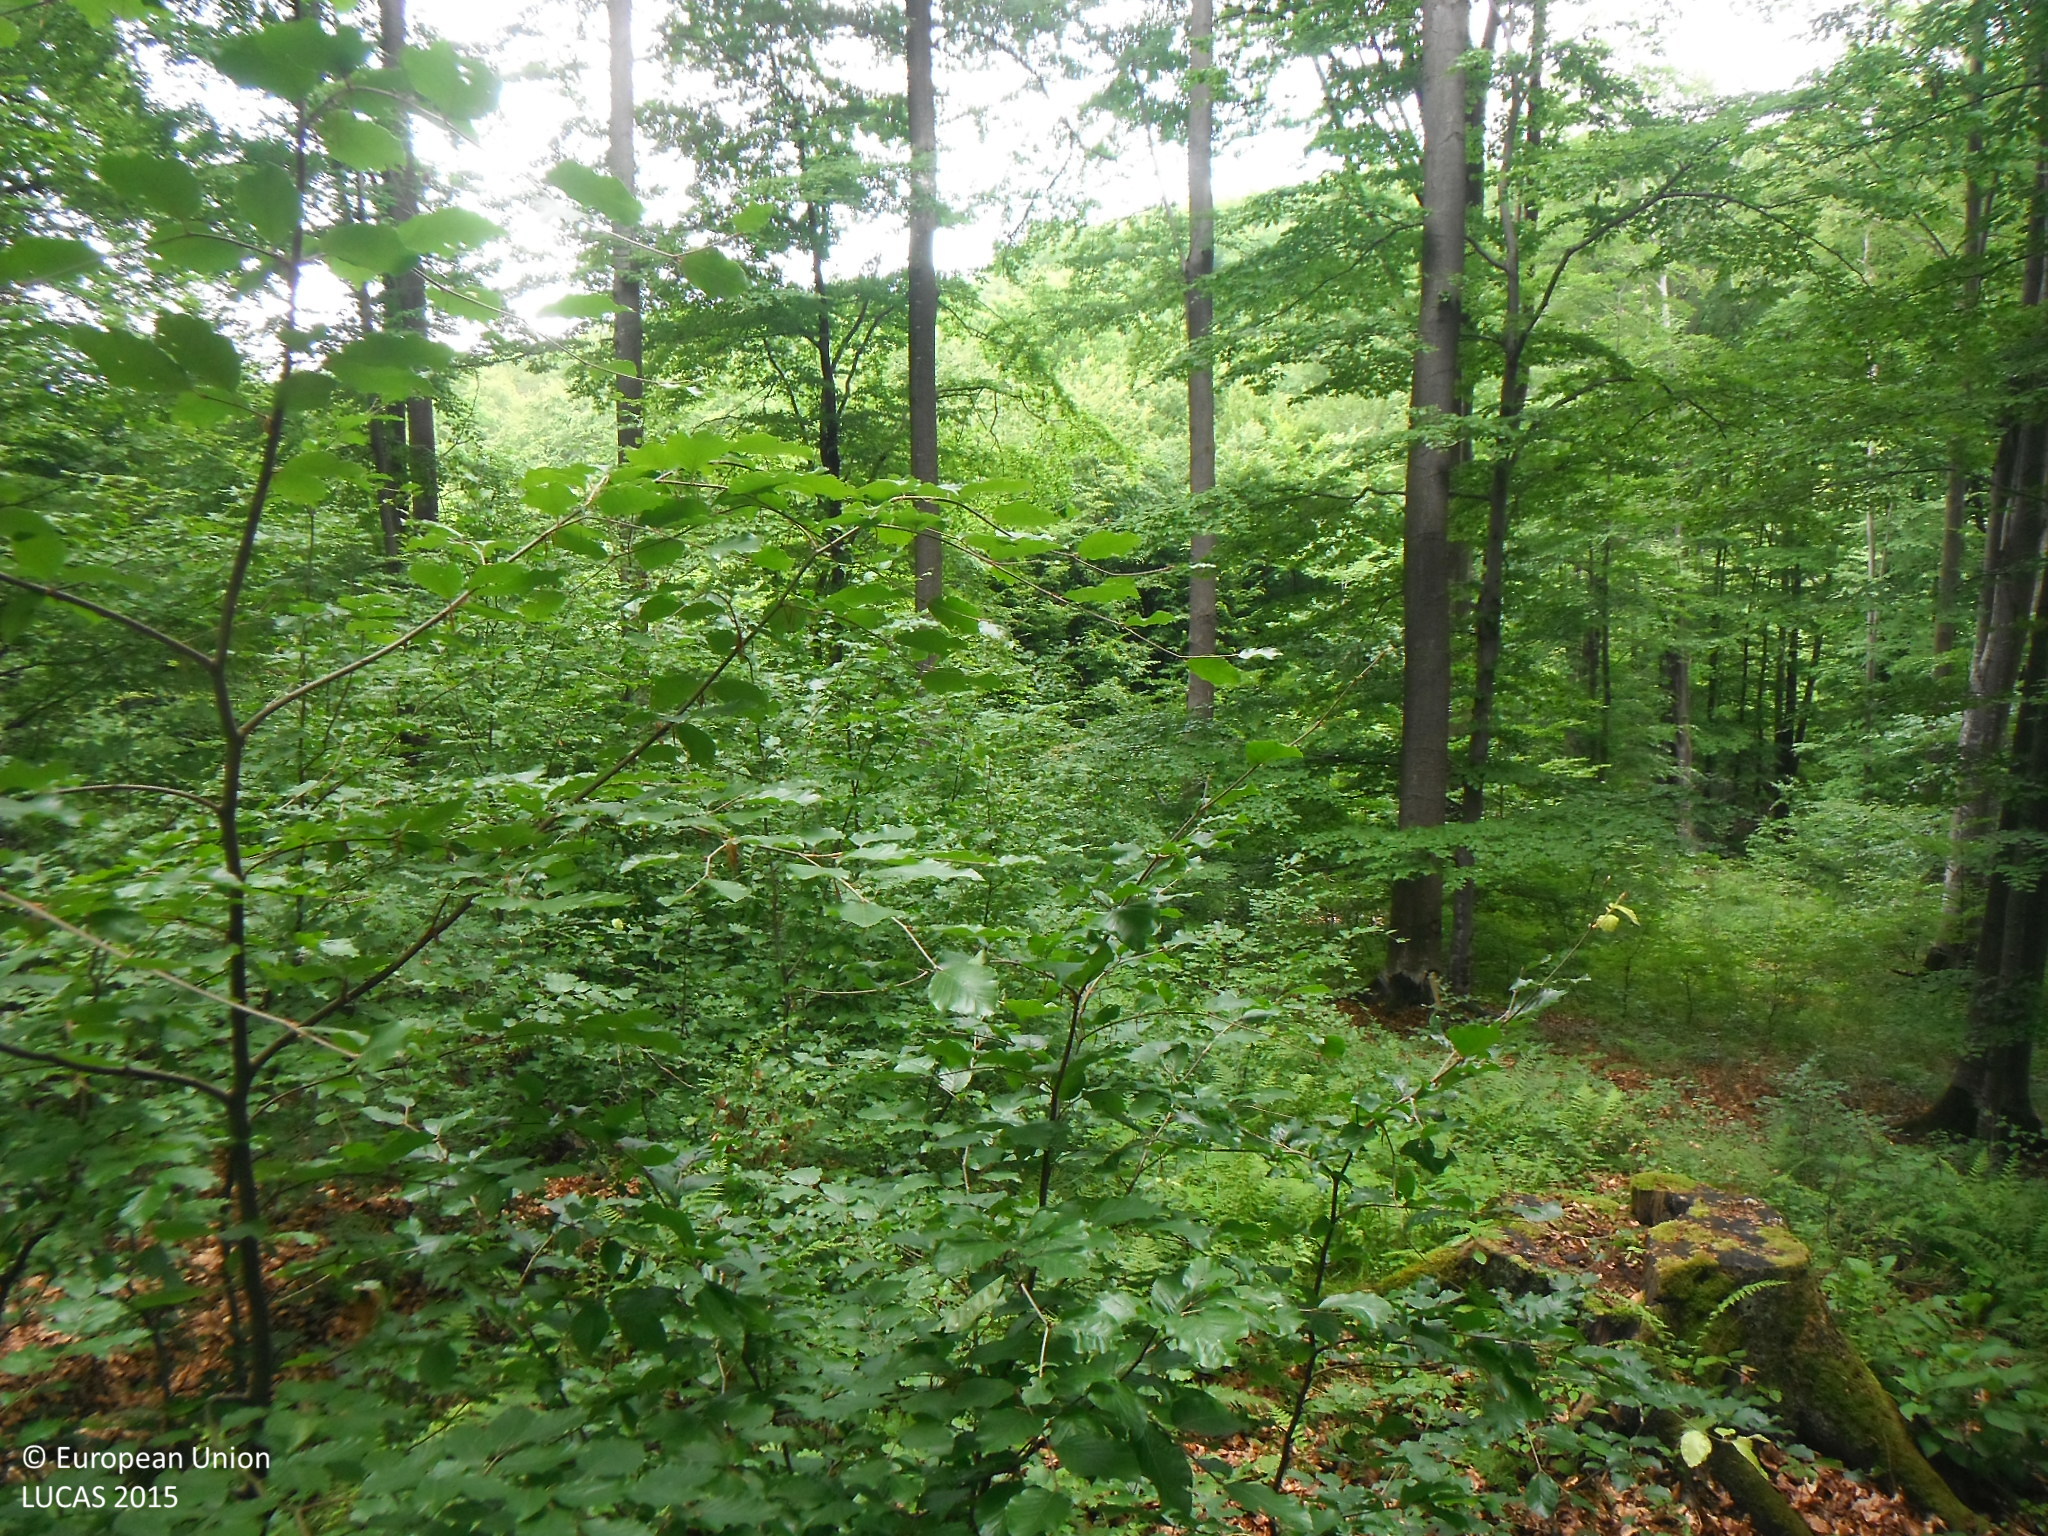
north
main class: Woodland
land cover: Broadleaved woodland
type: beech forest
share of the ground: > 75 %
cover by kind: broadleaved forest trees 80 %, herbaceous plants 15 %, lichens and mosses 5 %
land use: Forestry
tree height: > 5 m
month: June
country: SK
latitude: 49.0565
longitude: 22.0021
